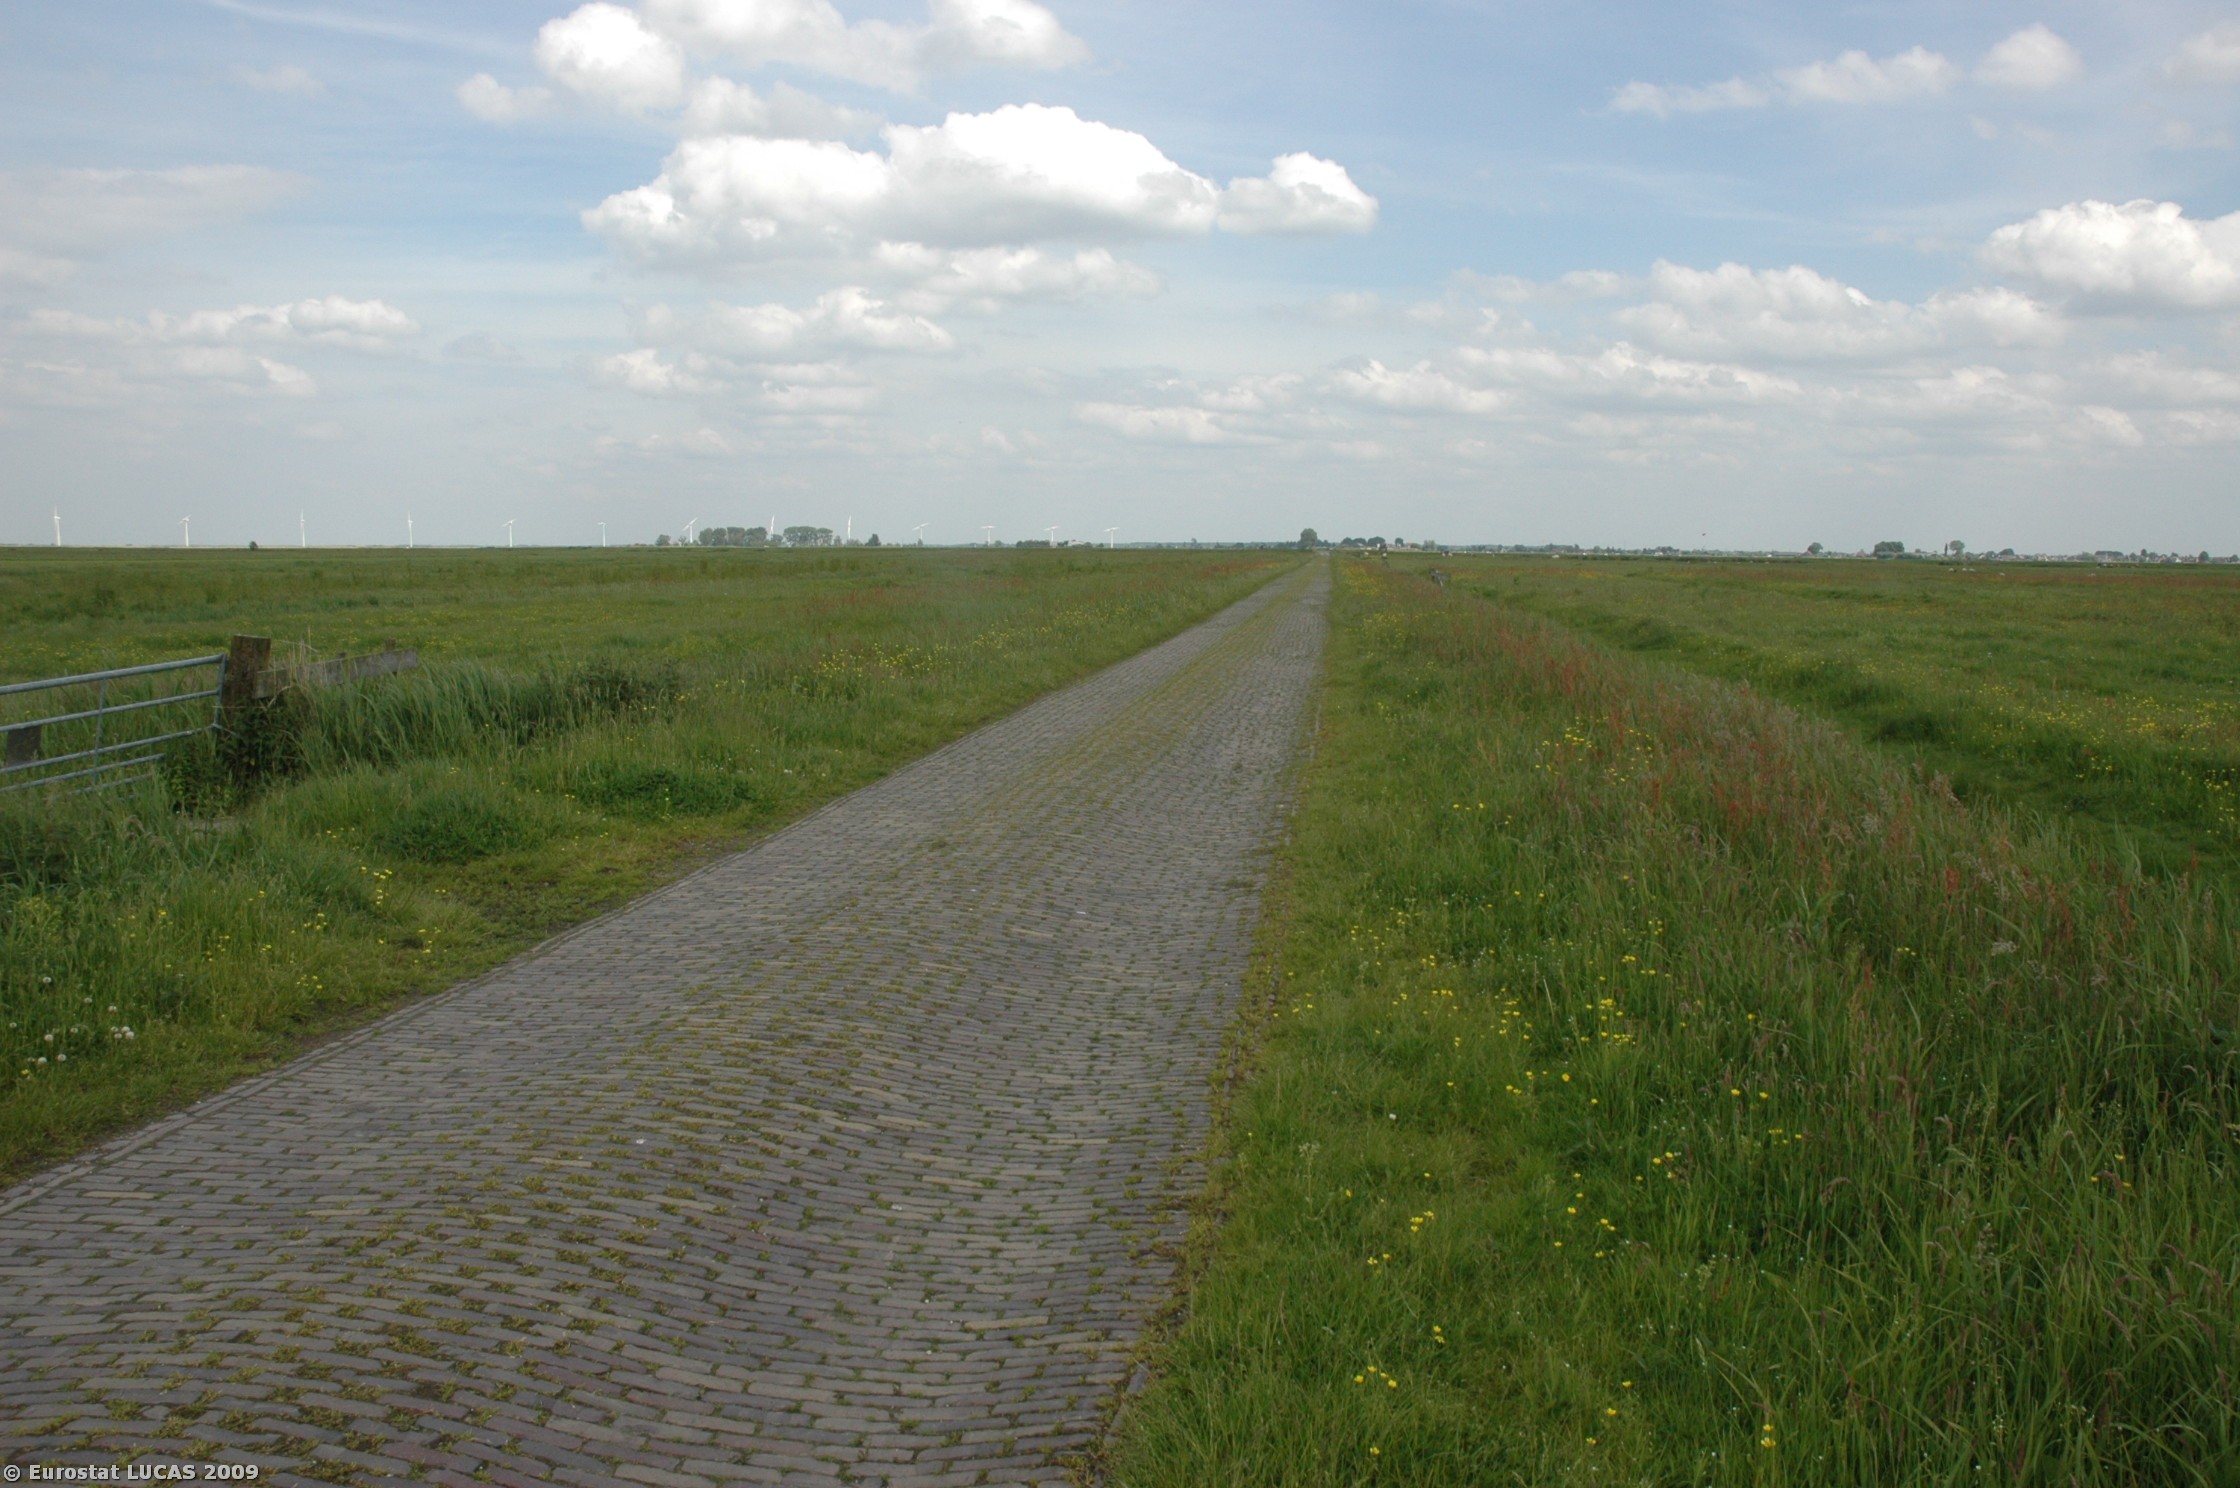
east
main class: Grassland
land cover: Grassland without tree/shrub cover
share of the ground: > 75 %
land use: Agriculture (excluding fallow land and kitchen gardens)
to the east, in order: Grassland without tree/shrub cover; Ditches and canals; Grassland without tree/shrub cover; Ditches and canals; Grassland without tree/shrub cover
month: May
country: NL
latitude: 52.2662
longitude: 5.2943
